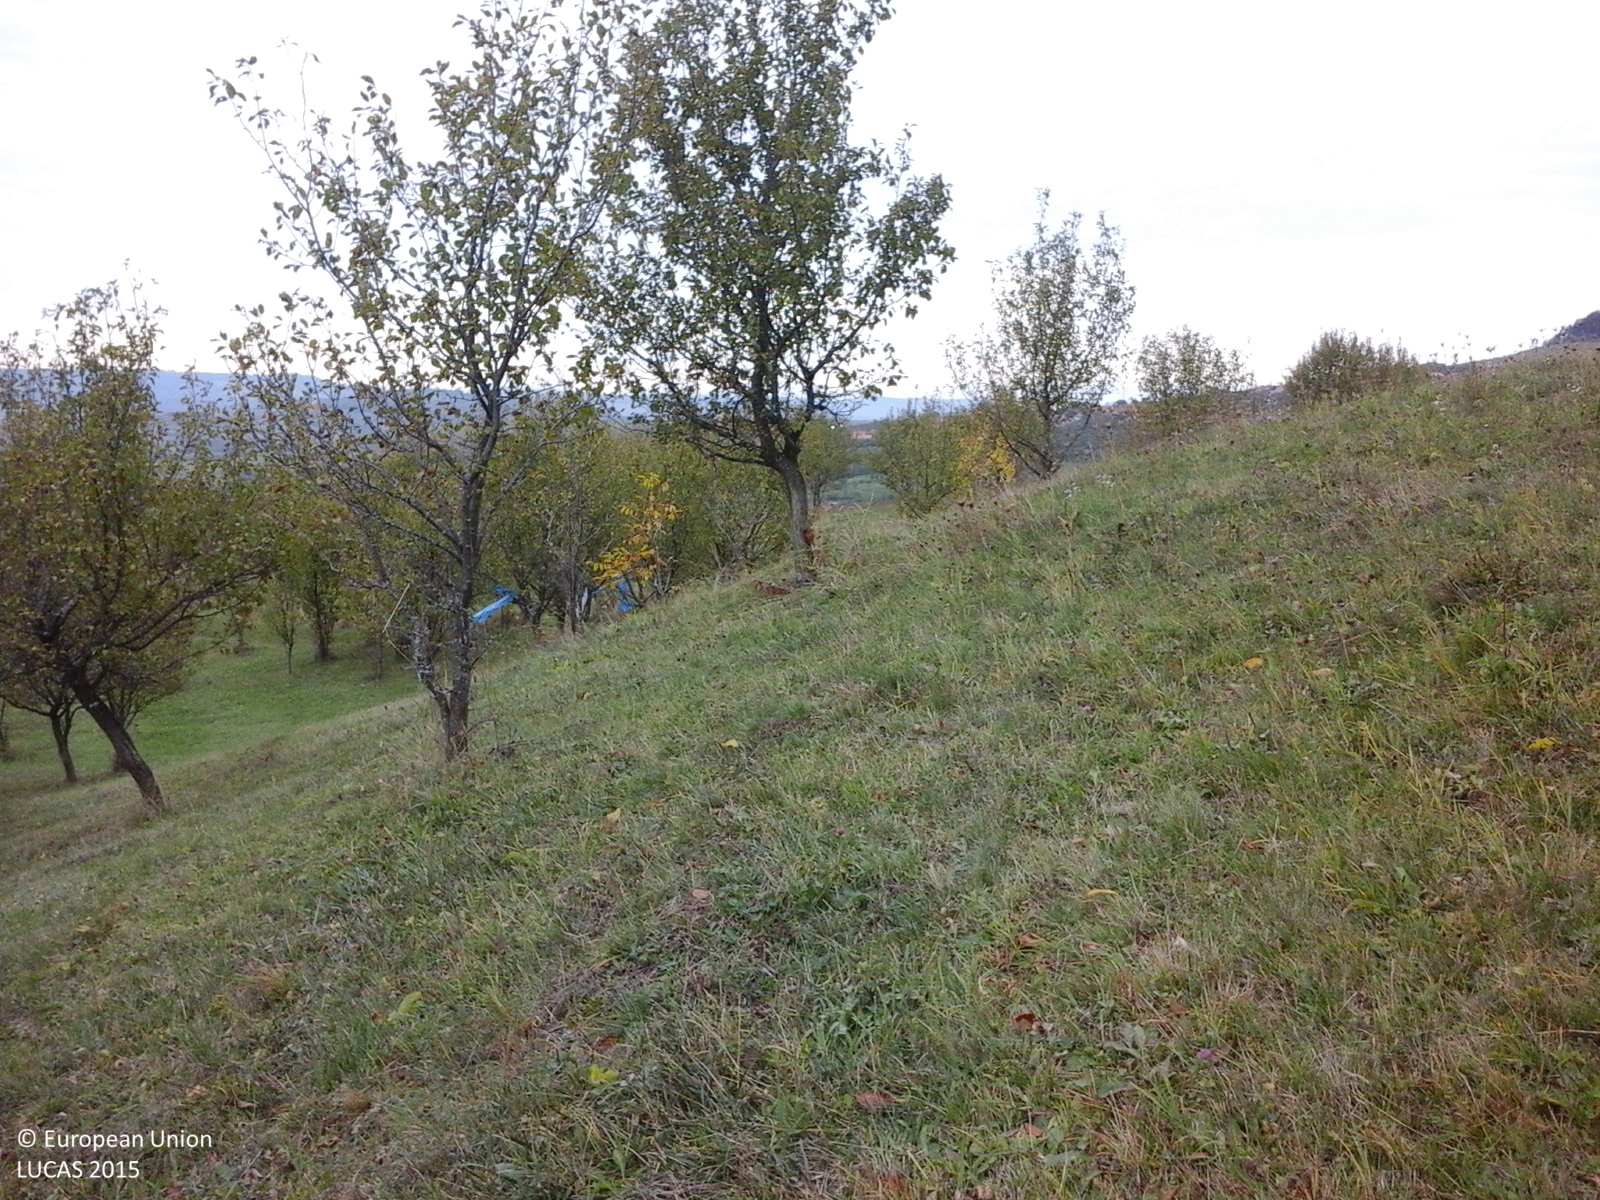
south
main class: Cropland
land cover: Apple fruit
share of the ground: > 75 %
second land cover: Grassland without tree/shrub cover
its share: > 75 %
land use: Agriculture (excluding fallow land and kitchen gardens)
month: October
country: RO
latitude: 46.4130
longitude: 25.3119
